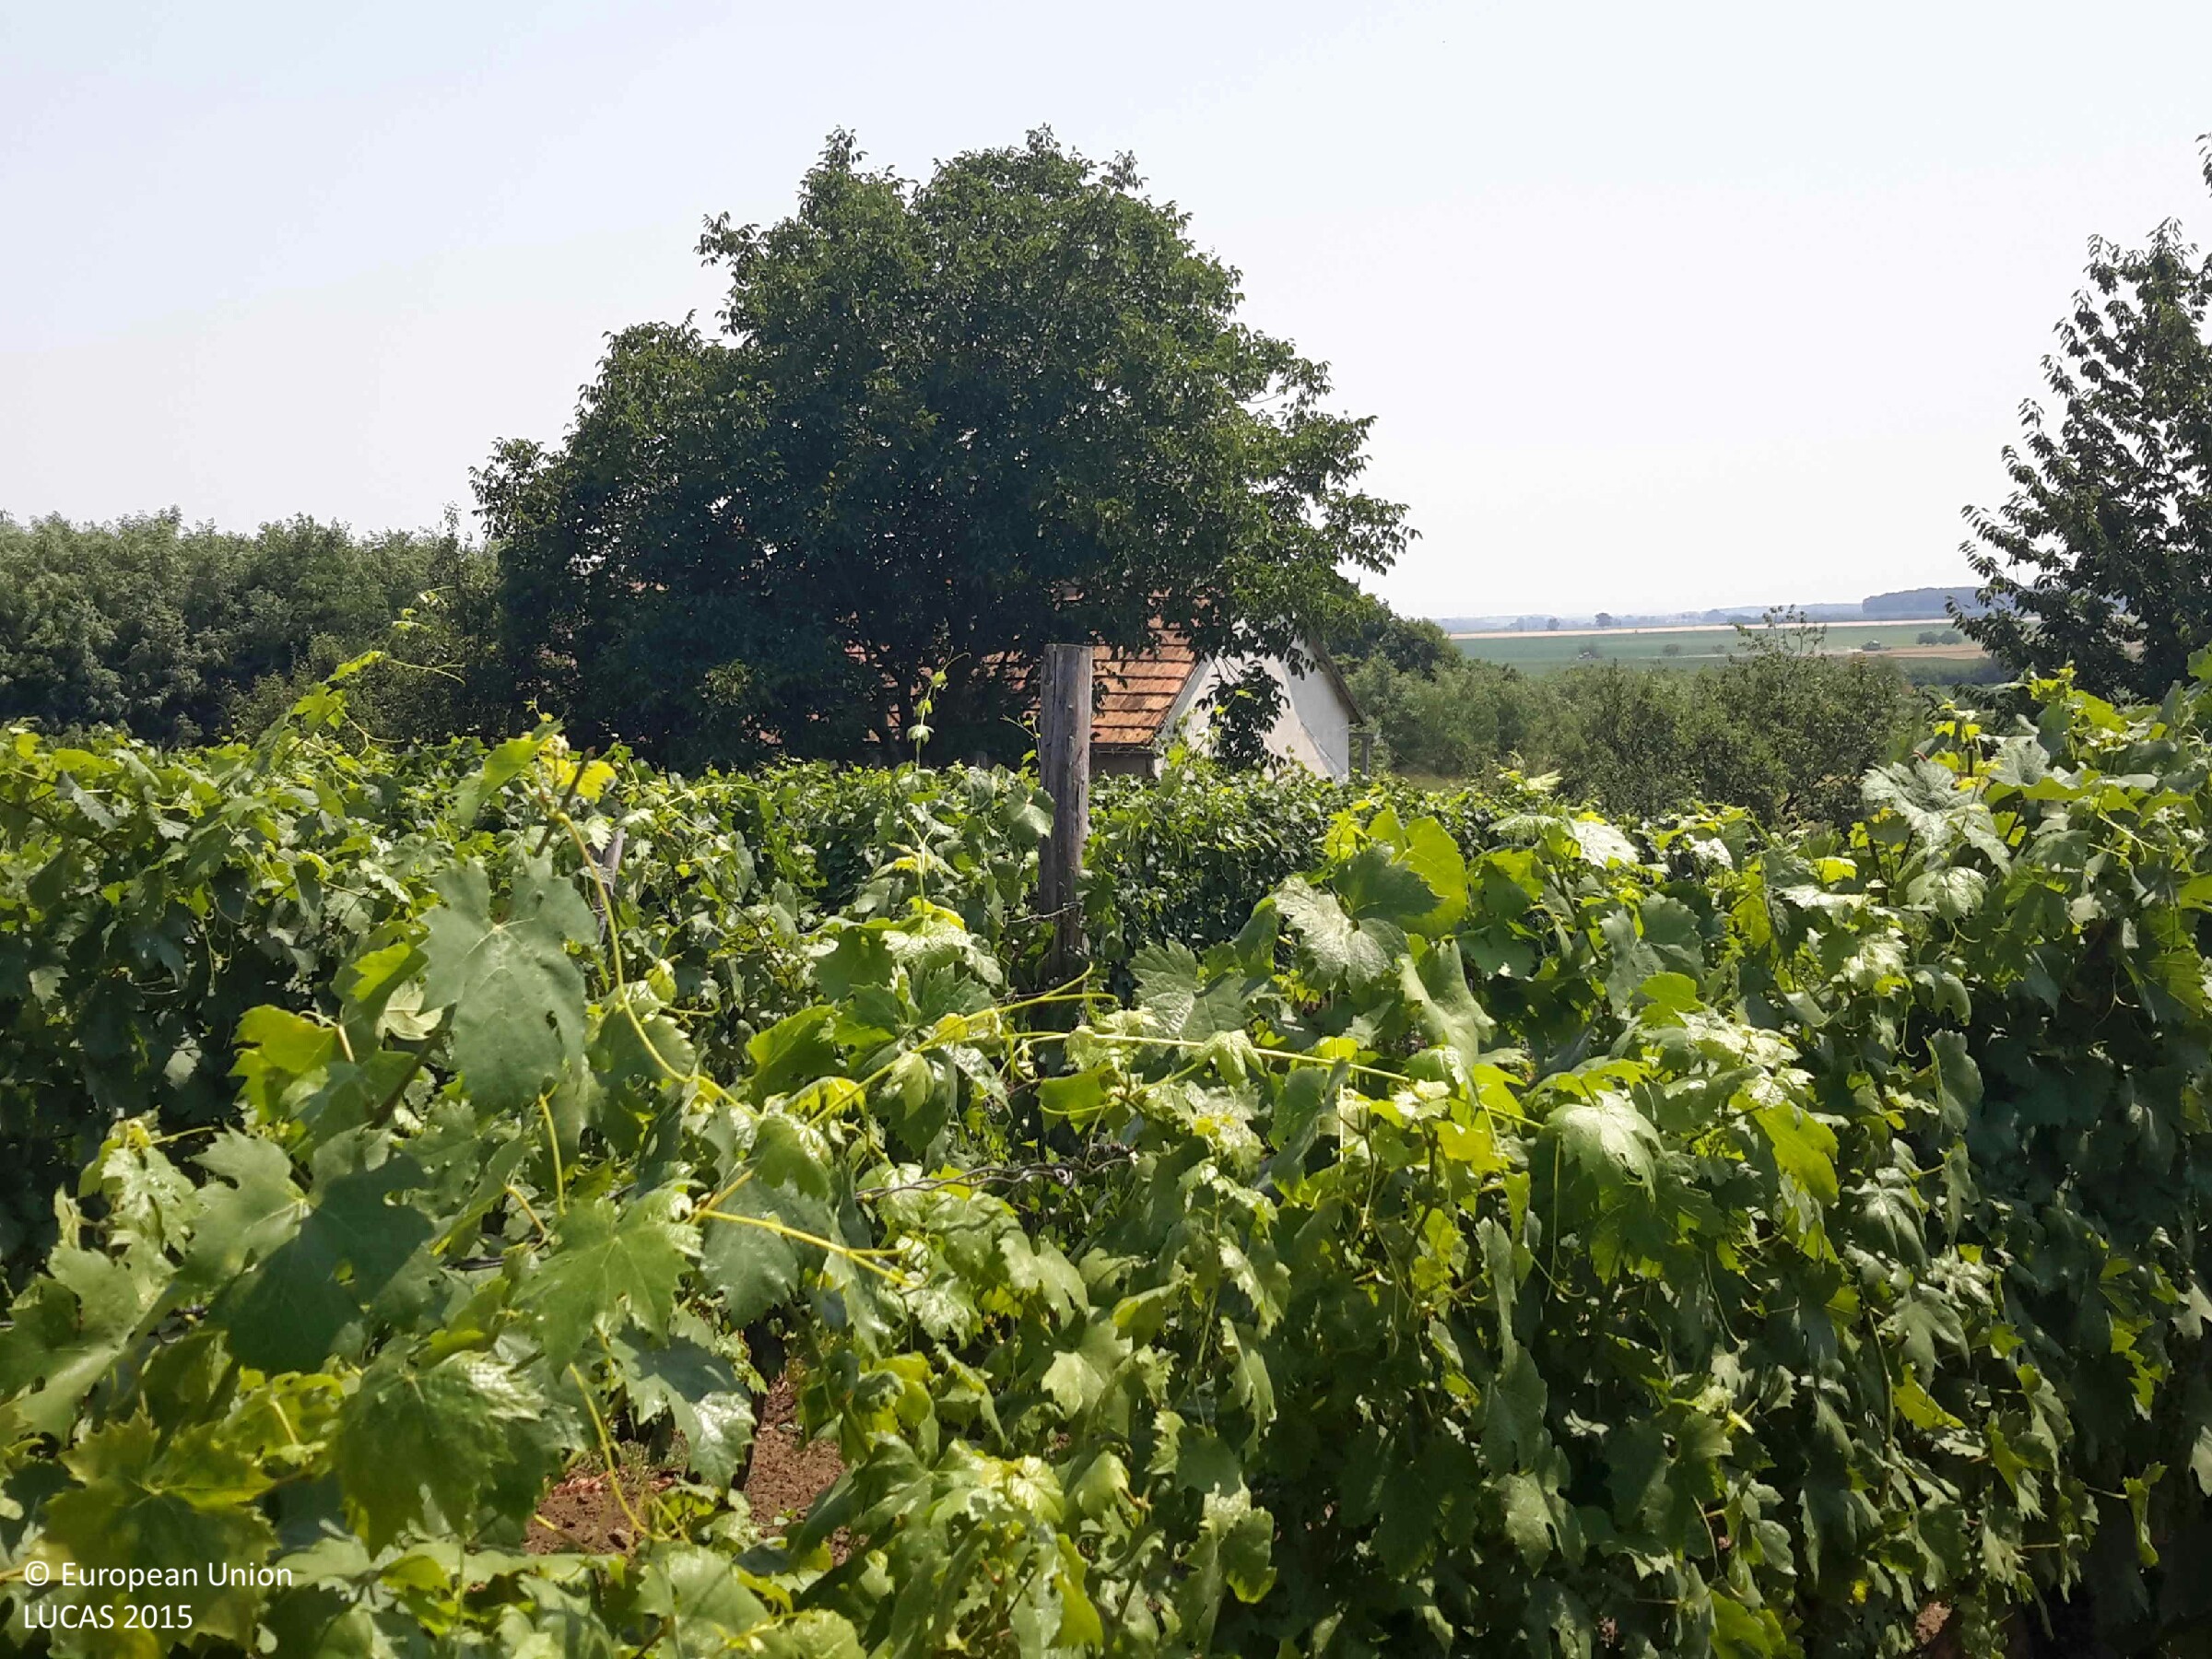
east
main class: Cropland
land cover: Vineyards
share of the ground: 25 - 50 %
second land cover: Other bare soil
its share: > 75 %
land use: Agriculture (excluding fallow land and kitchen gardens)
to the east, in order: Vineyards; Other bare soil; Artificial constructions in urban areas; Grassland with sparse tree/shrub cover; Maize; Barley; Broadleaved woodland; Grassland with sparse tree/shrub cover; Vineyards; Maize; Vineyards; Common wheat; Grassland with sparse tree/shrub cover; Maize
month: July
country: HU
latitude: 47.2213
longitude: 17.0438
